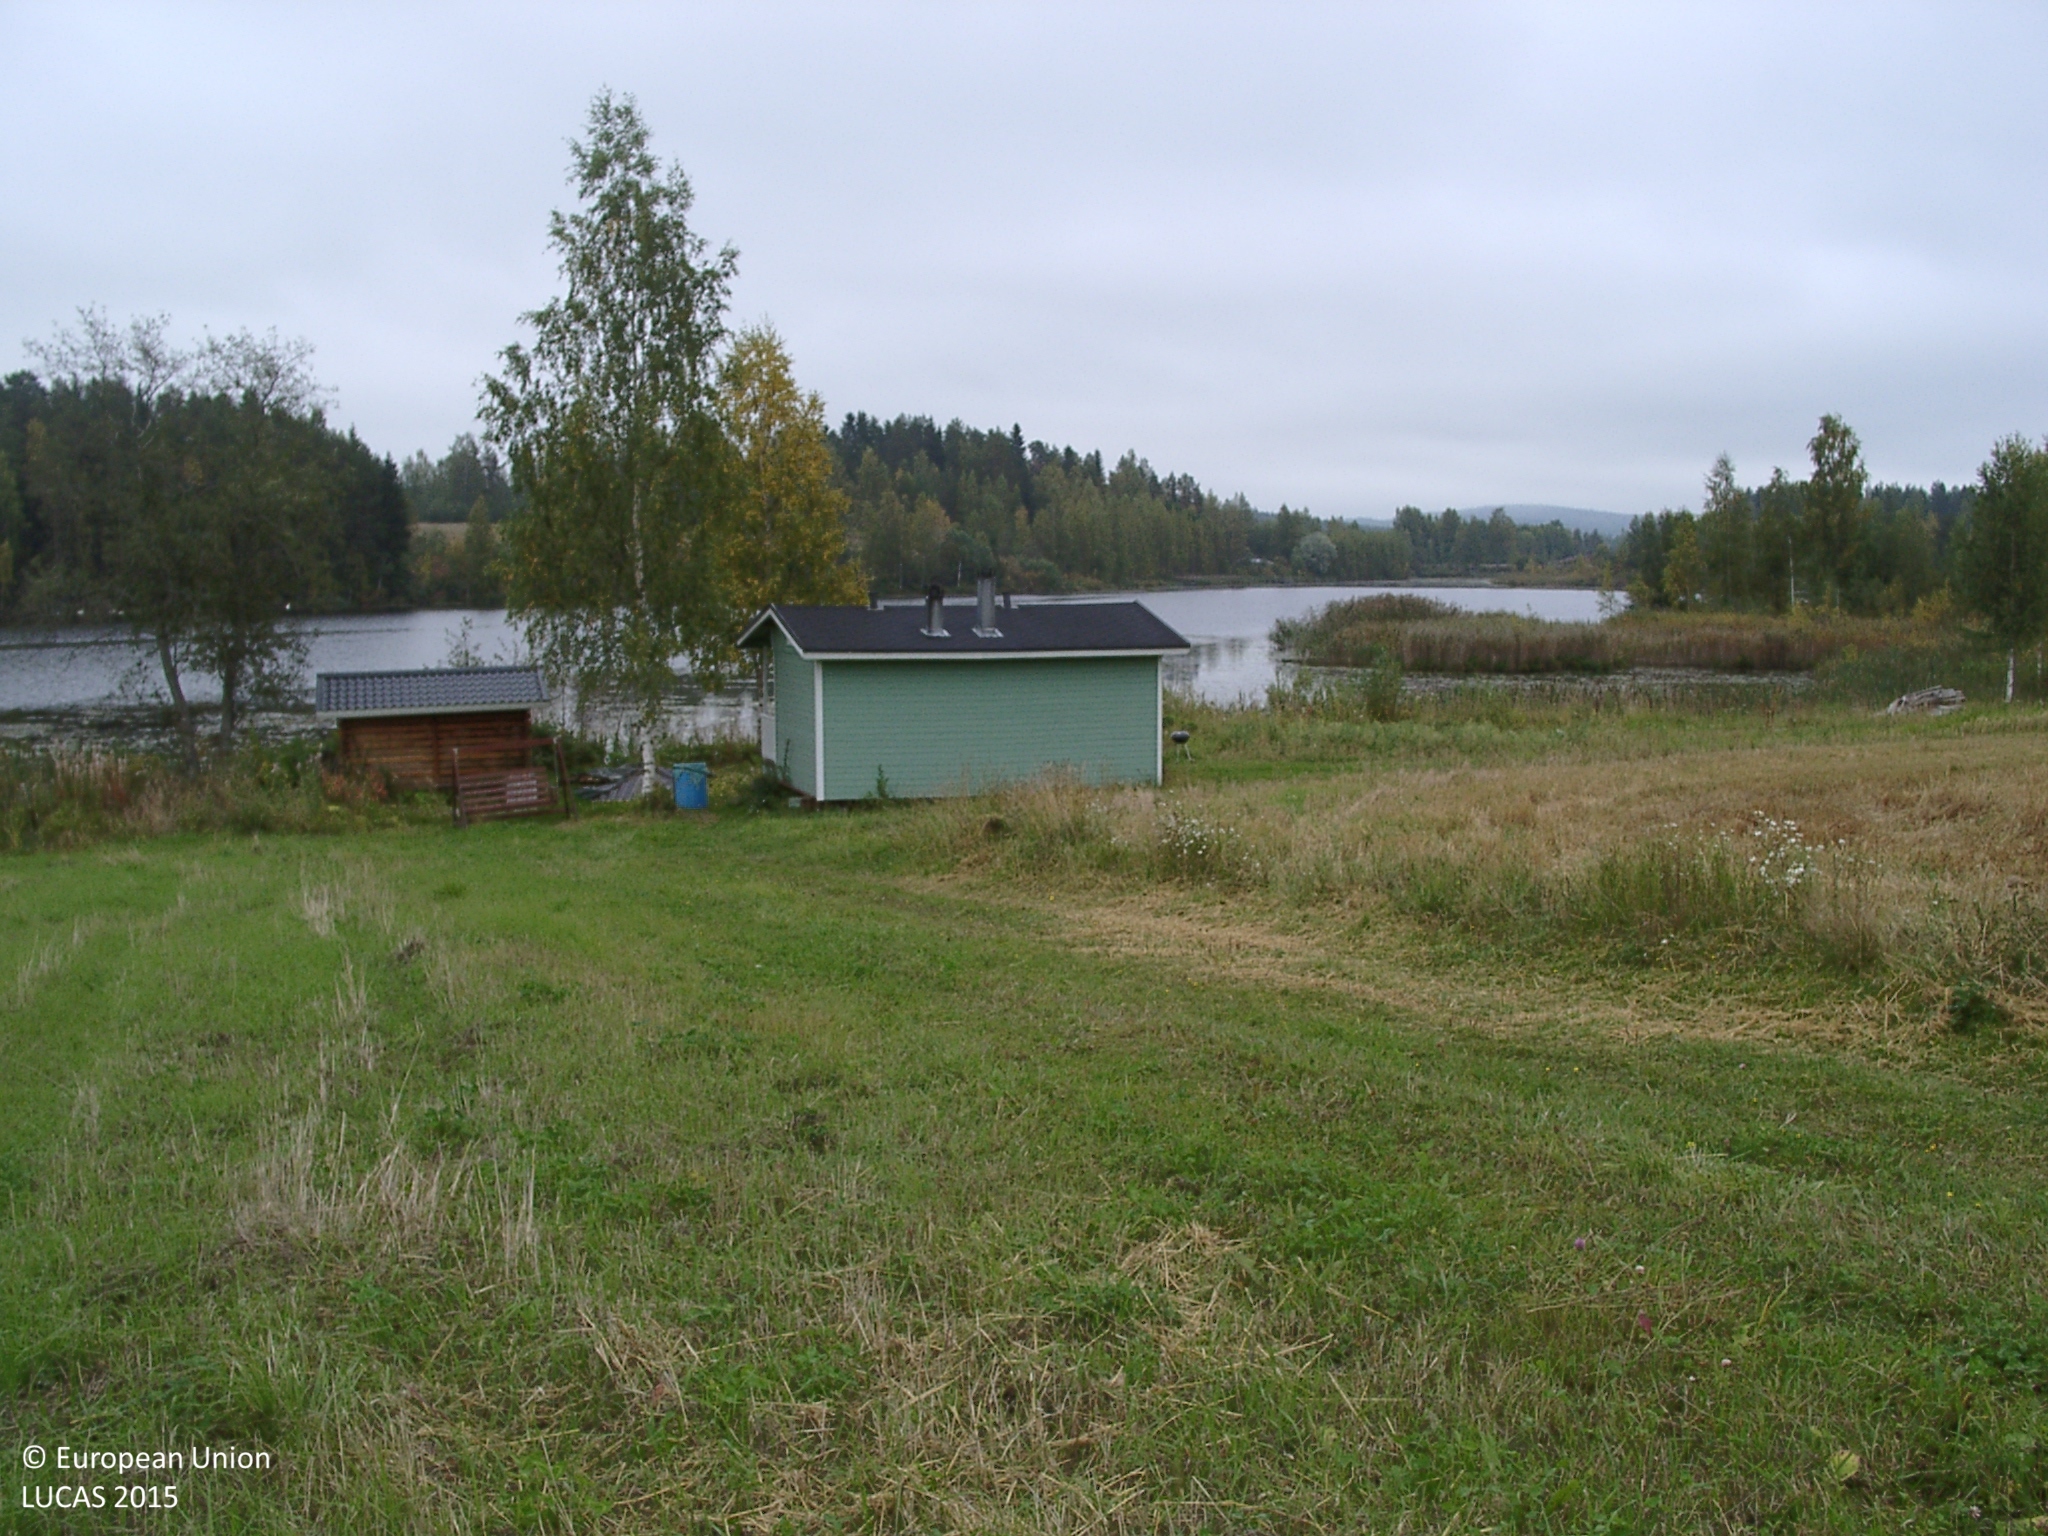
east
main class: Cropland
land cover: Other leguminous and mixtures for fodder
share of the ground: > 75 %
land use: Agriculture (excluding fallow land and kitchen gardens)
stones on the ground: < 10 %
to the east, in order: Other leguminous and mixtures for fodder; Grass margins; Artificial constructions in urban areas; Inland marshes; Inland fresh water bodies
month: September
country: FI
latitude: 62.5781
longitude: 25.6663
